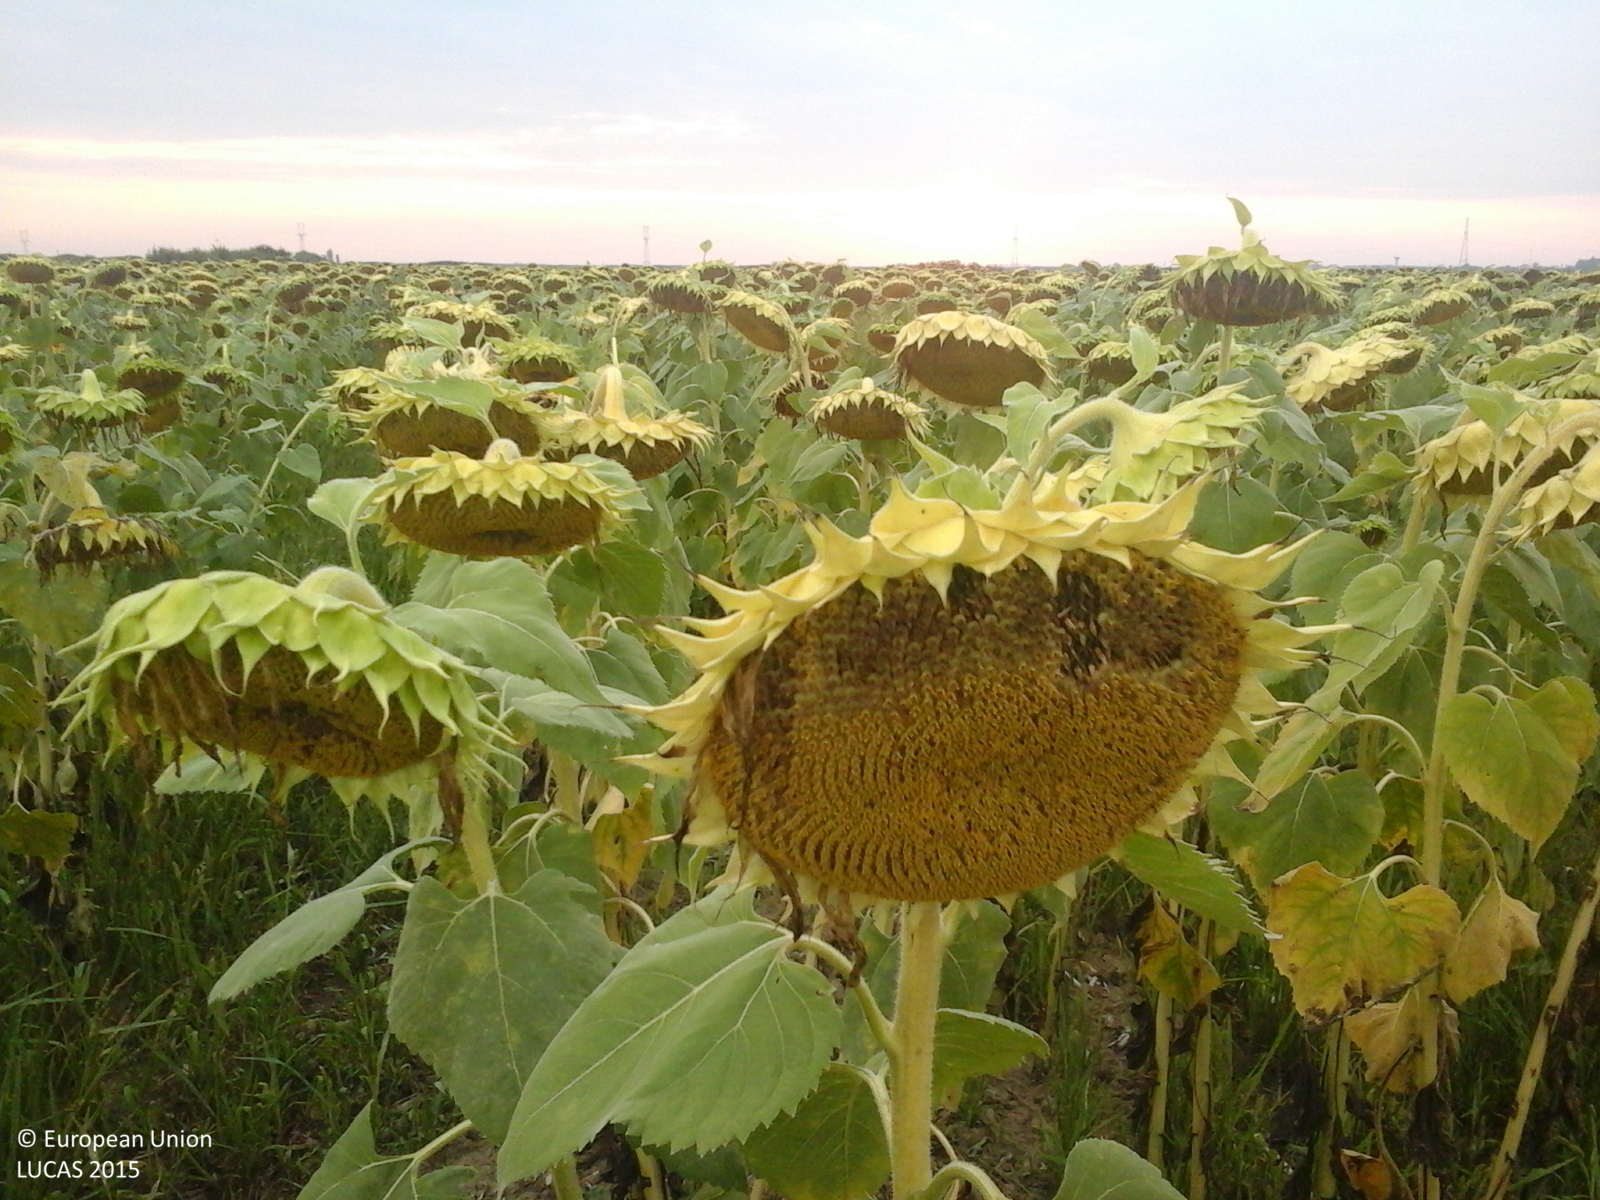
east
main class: Cropland
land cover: Sunflower
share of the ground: > 75 %
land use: Agriculture (excluding fallow land and kitchen gardens)
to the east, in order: Sunflower; Grass margins; Abandoned hedges; Ditches and canals; Abandoned hedges; Grass margins; Sunflower; Grass margins; Ditches and canals; Grass margins; Tracks; Other bare soil
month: August
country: RO
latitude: 46.5029
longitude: 21.5711
